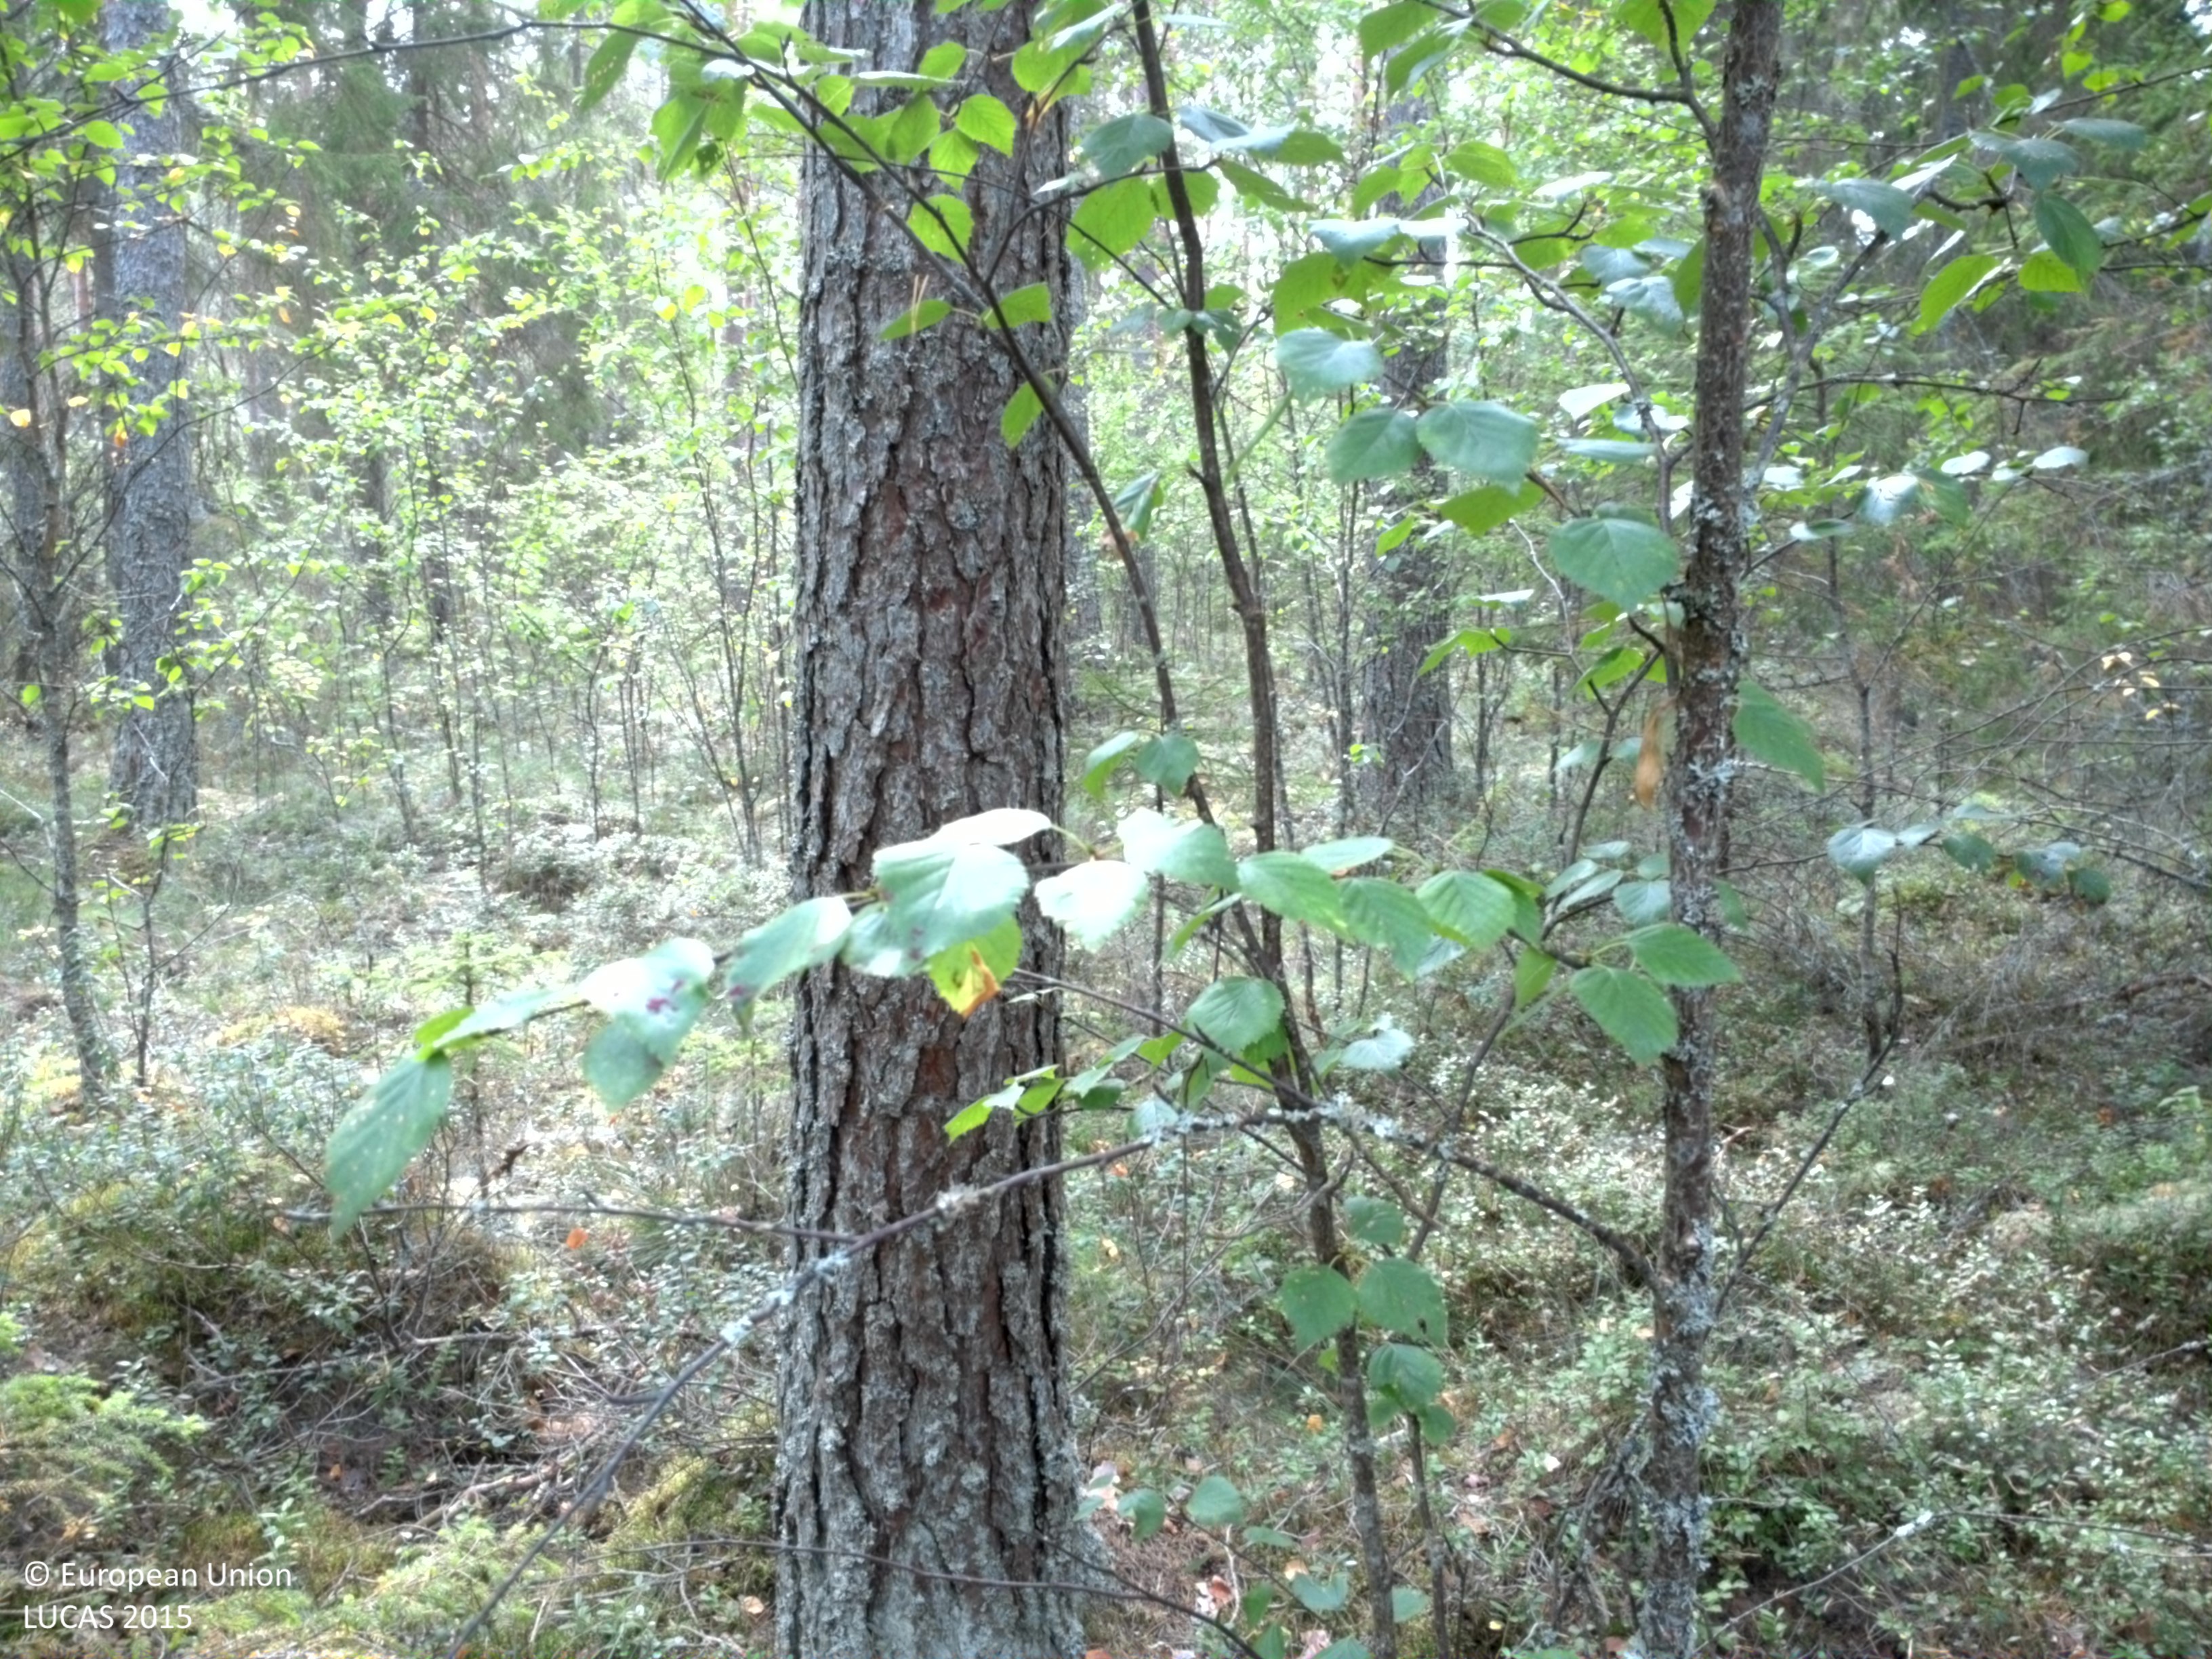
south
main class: Woodland
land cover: Pine dominated mixed woodland
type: boreal forest
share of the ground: 50 - 75 %
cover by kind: coniferous forest trees 40 %, broadleaved forest trees 25 %, shrubs 20 %, lichens and mosses 10 %, herbaceous plants 5 %
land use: Forestry
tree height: > 5 m
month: August
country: SE
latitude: 59.8883
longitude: 15.6189
